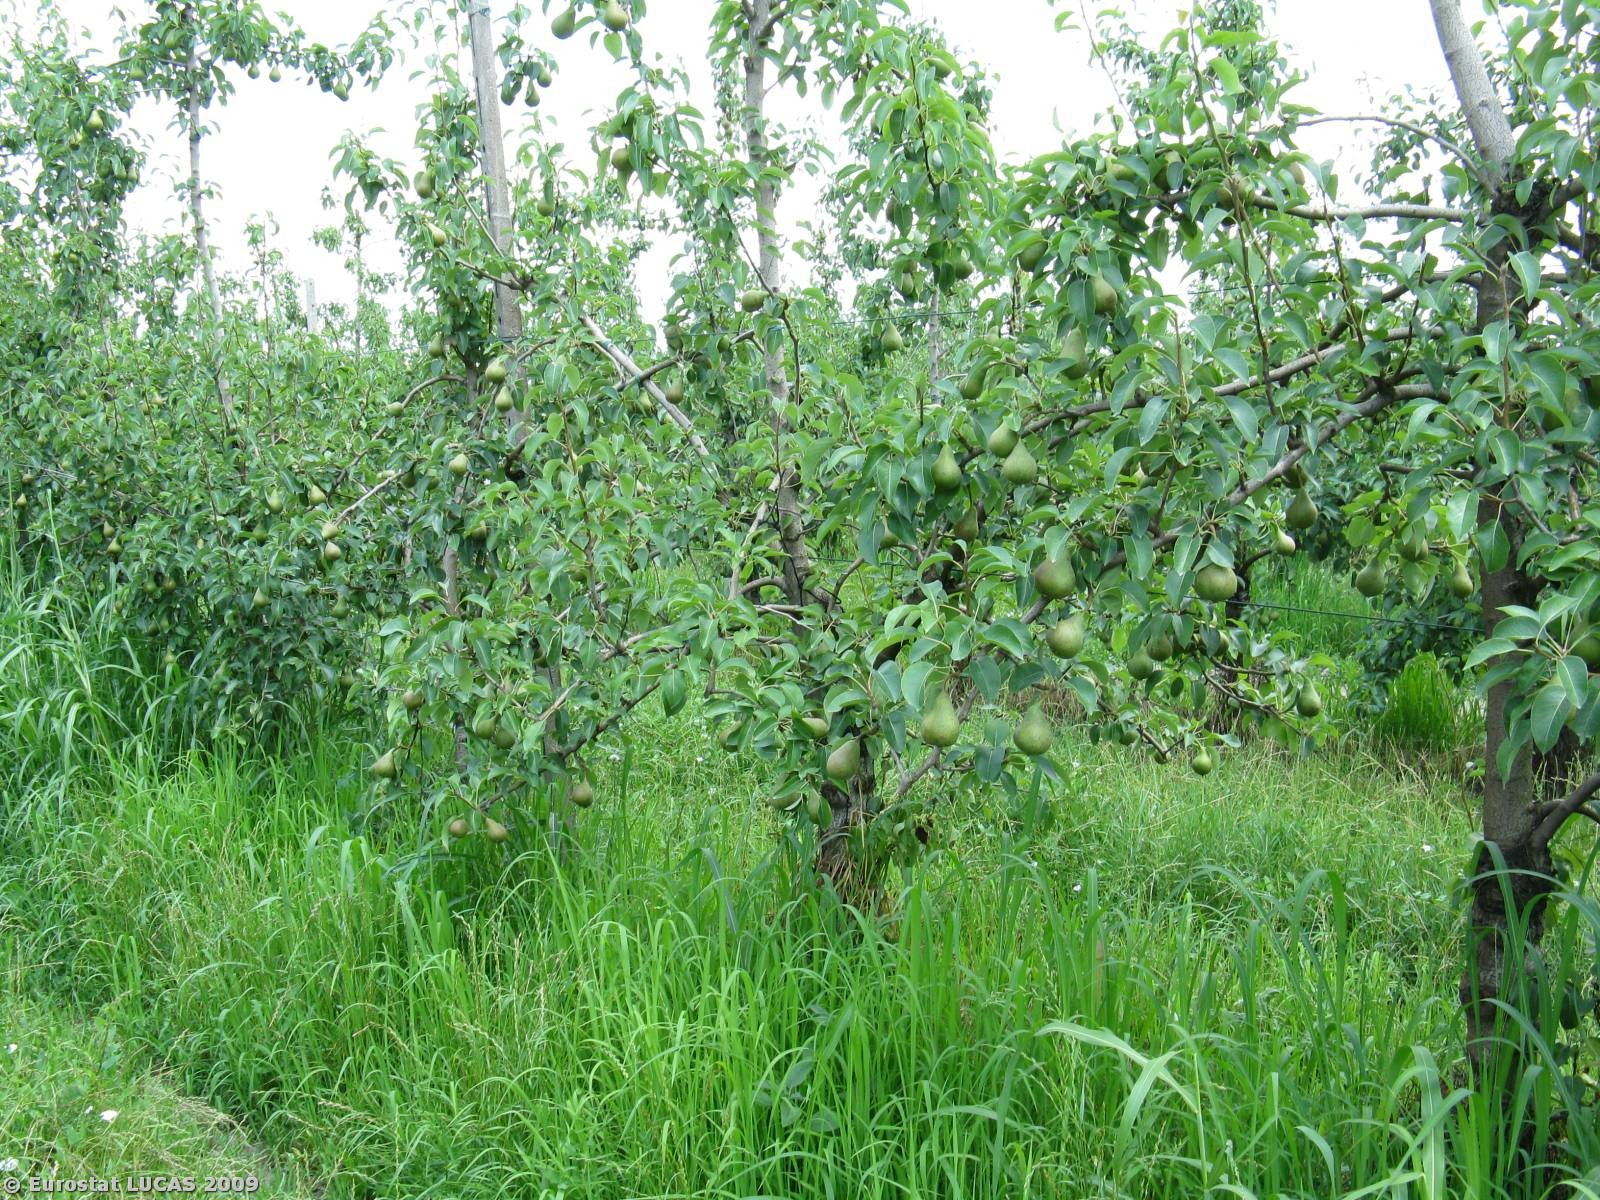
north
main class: Cropland
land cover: Pear fruit
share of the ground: 50 - 75 %
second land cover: Grassland with sparse tree/shrub cover
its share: 50 - 75 %
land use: Agriculture (excluding fallow land and kitchen gardens)
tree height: < 5 m
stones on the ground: < 10 %
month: June
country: IT
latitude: 44.7162
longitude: 11.6503
